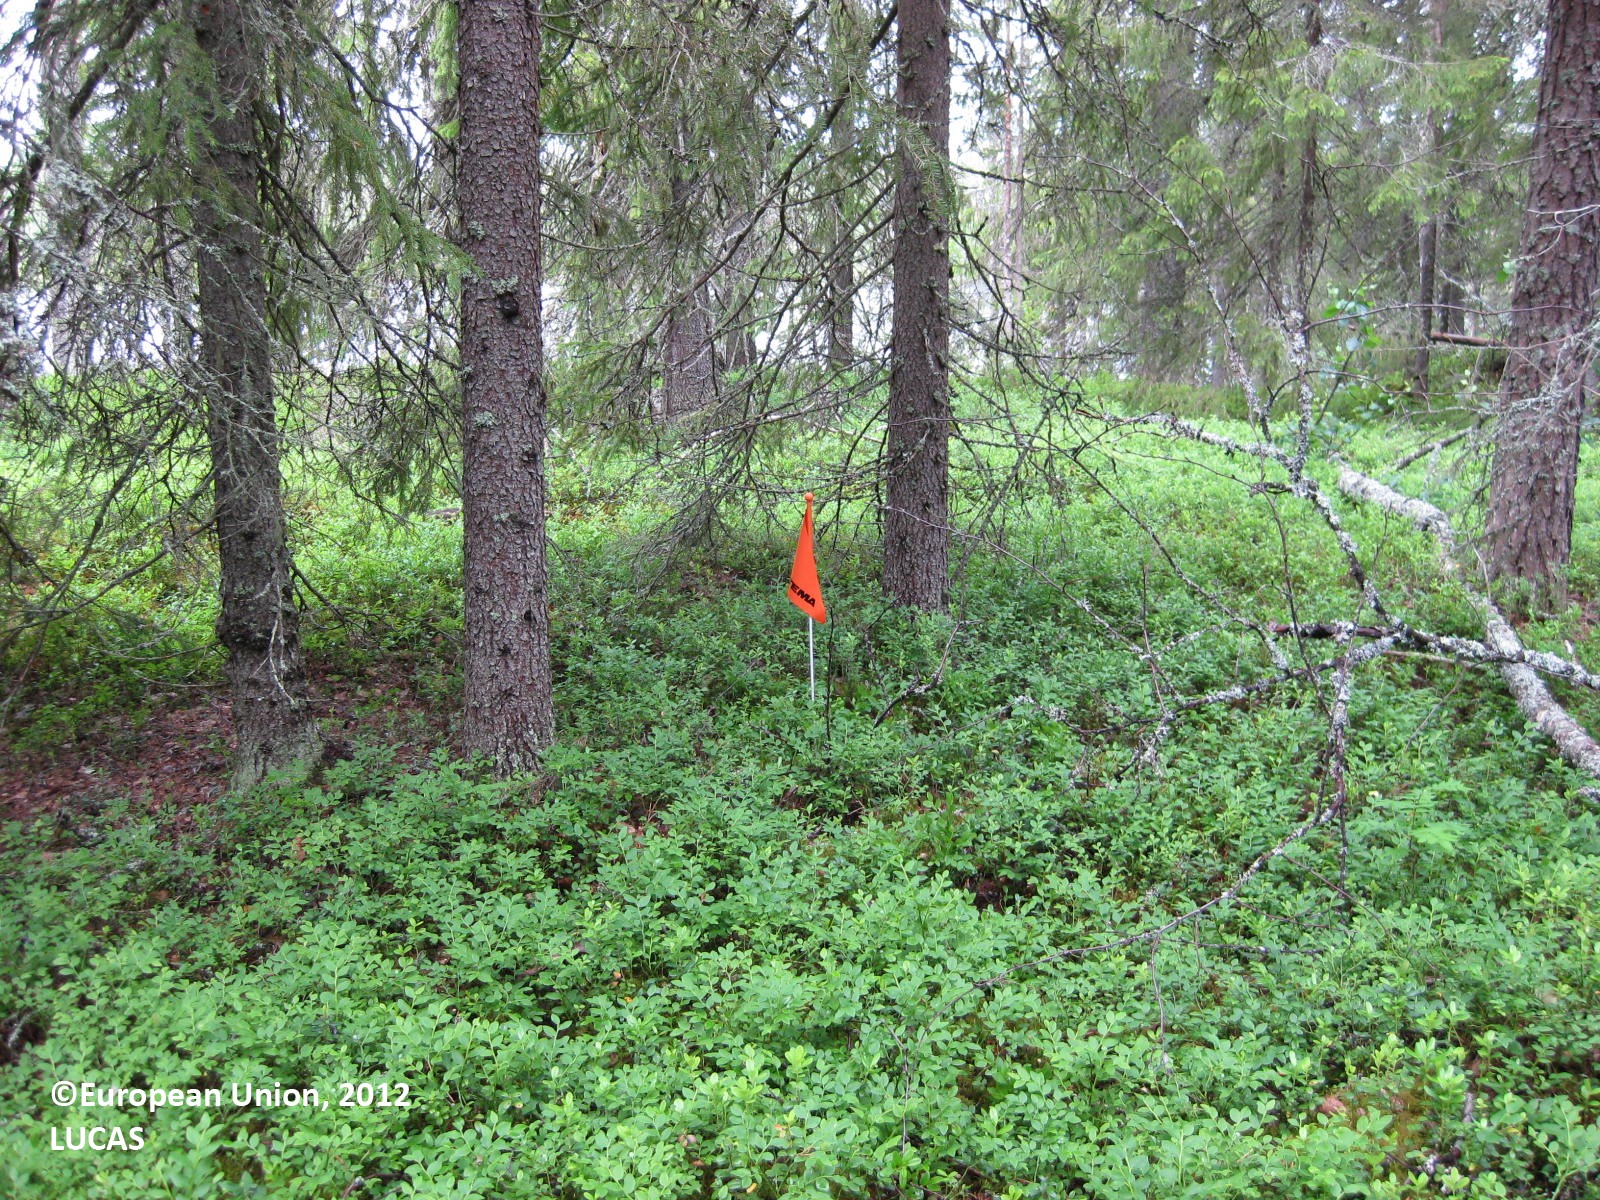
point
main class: Woodland
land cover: Spruce dominated mixed woodland
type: boreal forest
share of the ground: > 75 %
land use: Forestry
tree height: > 5 m
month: July
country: FI
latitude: 65.4657
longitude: 28.3067
